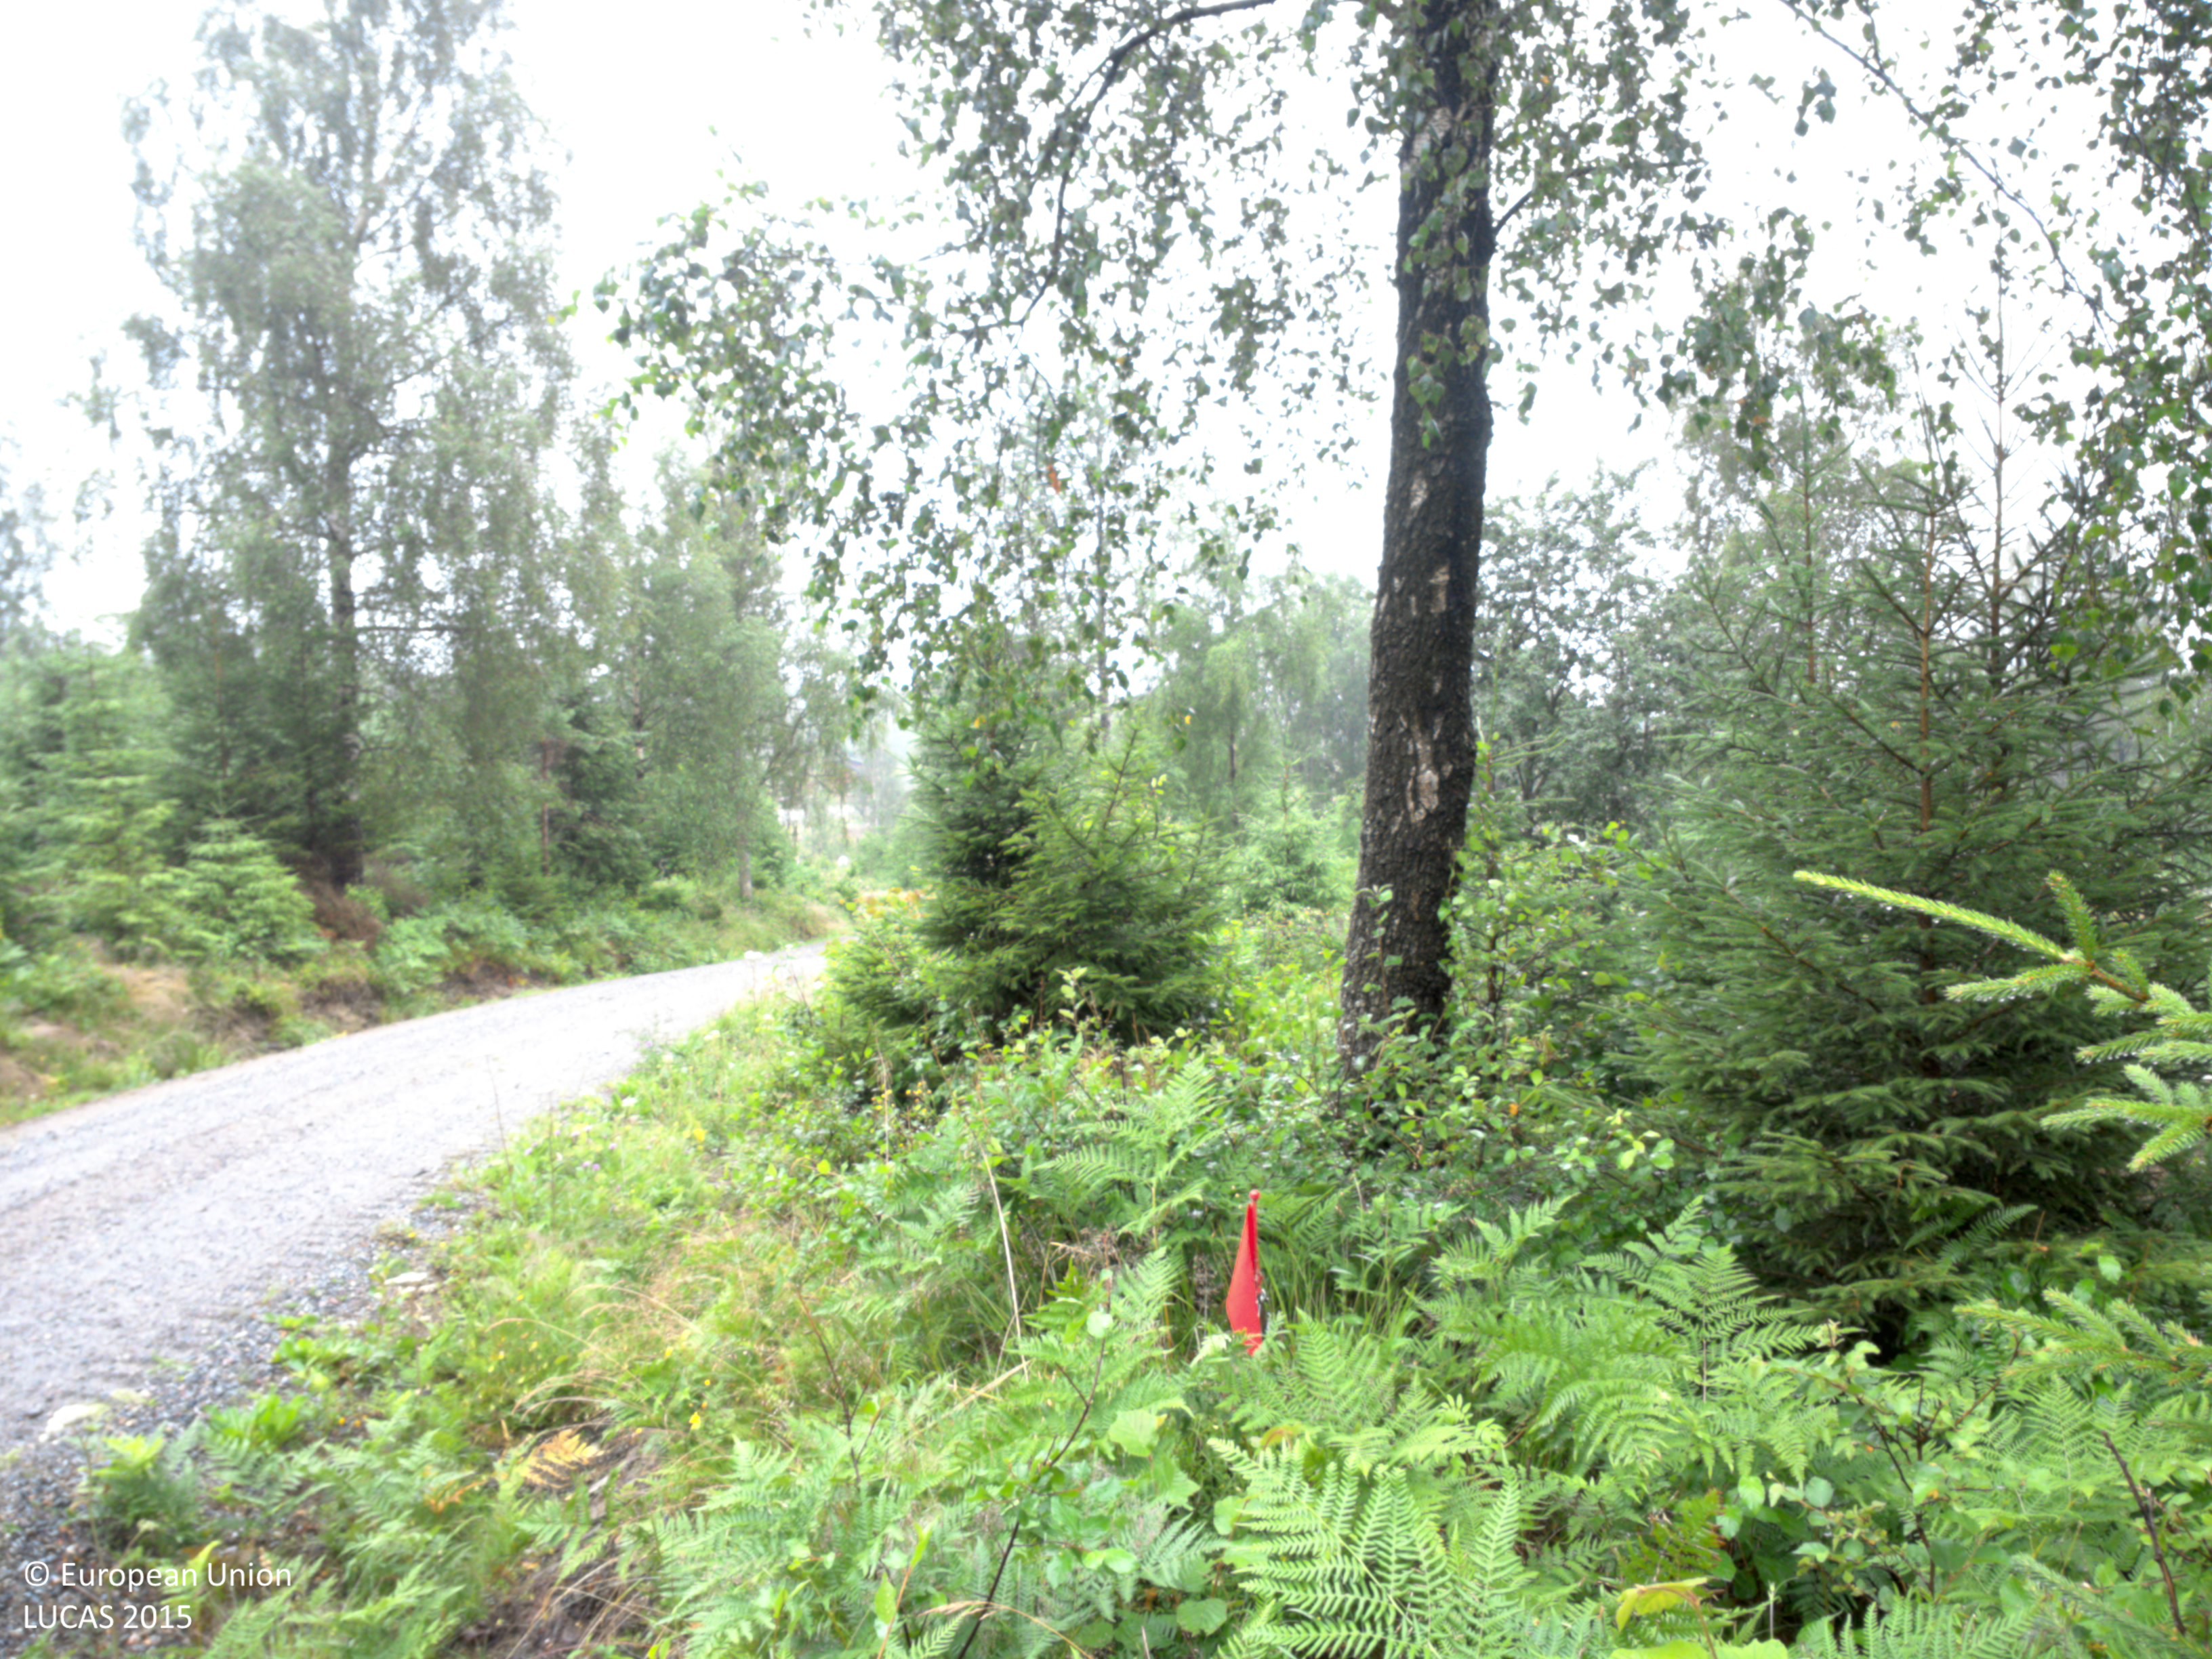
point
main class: Woodland
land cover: Spruce dominated mixed woodland
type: boreal forest
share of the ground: 50 - 75 %
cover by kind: coniferous forest trees 30 %, broadleaved forest trees 30 %, herbaceous plants 30 %, shrubs 10 %
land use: Forestry
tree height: > 5 m
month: July
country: SE
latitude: 58.6751
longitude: 11.8068
